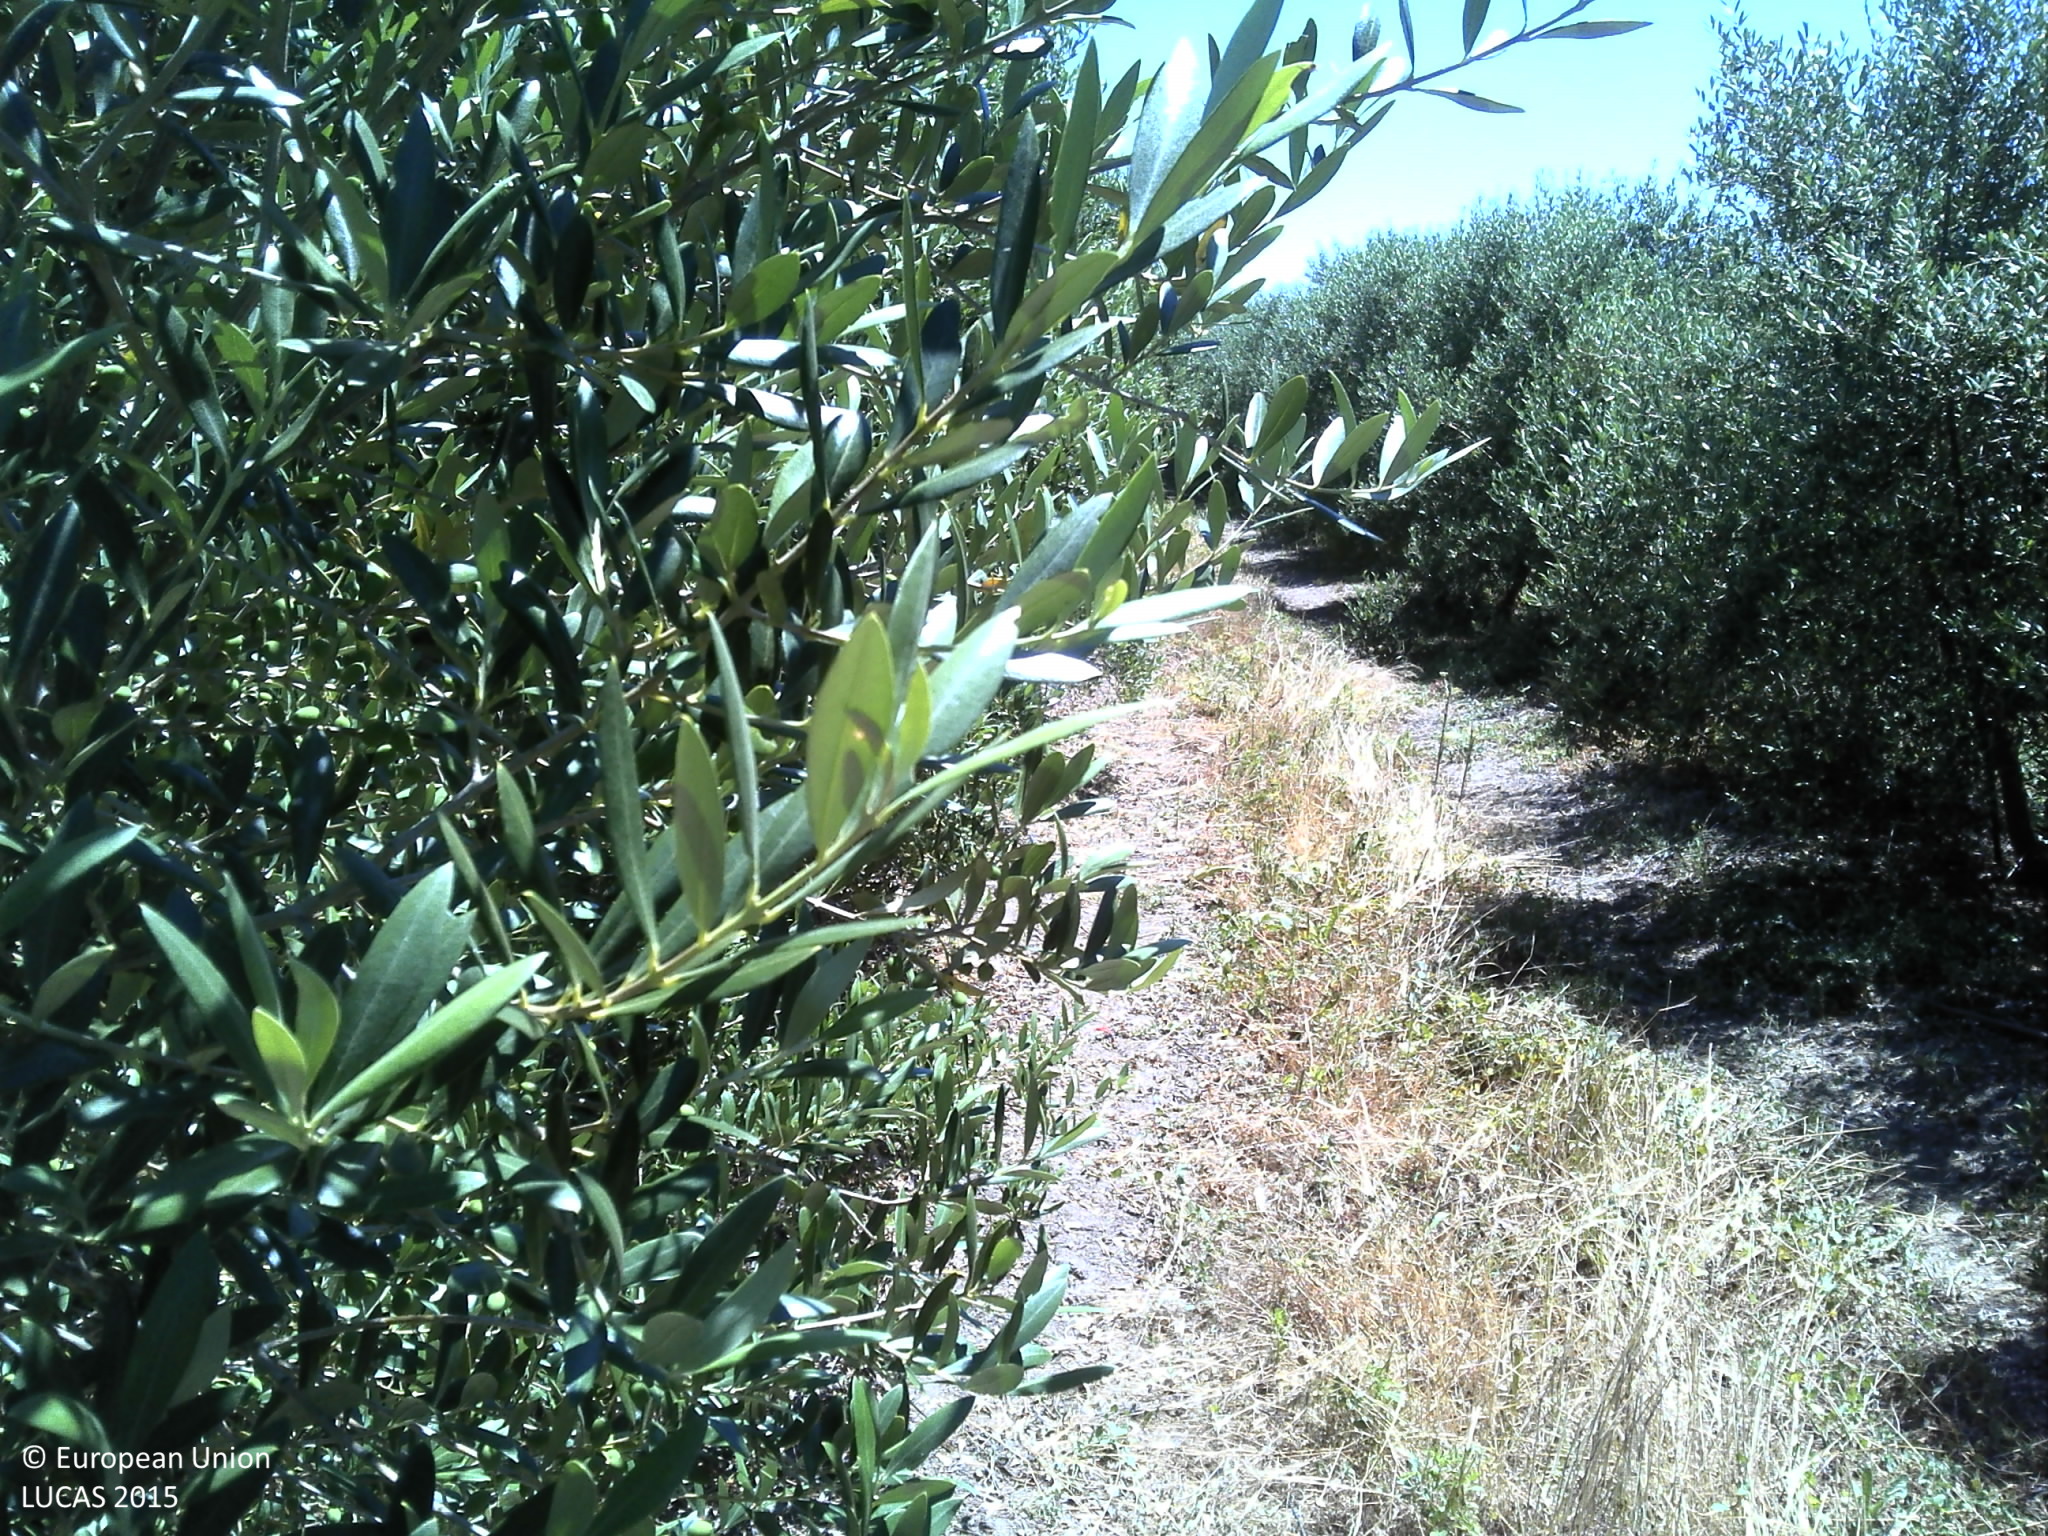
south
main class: Cropland
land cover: Olive groves
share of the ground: 50 - 75 %
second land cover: Grassland without tree/shrub cover
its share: 25 - 50 %
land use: Agriculture (excluding fallow land and kitchen gardens)
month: June
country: PT
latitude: 37.9538
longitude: -7.5341
